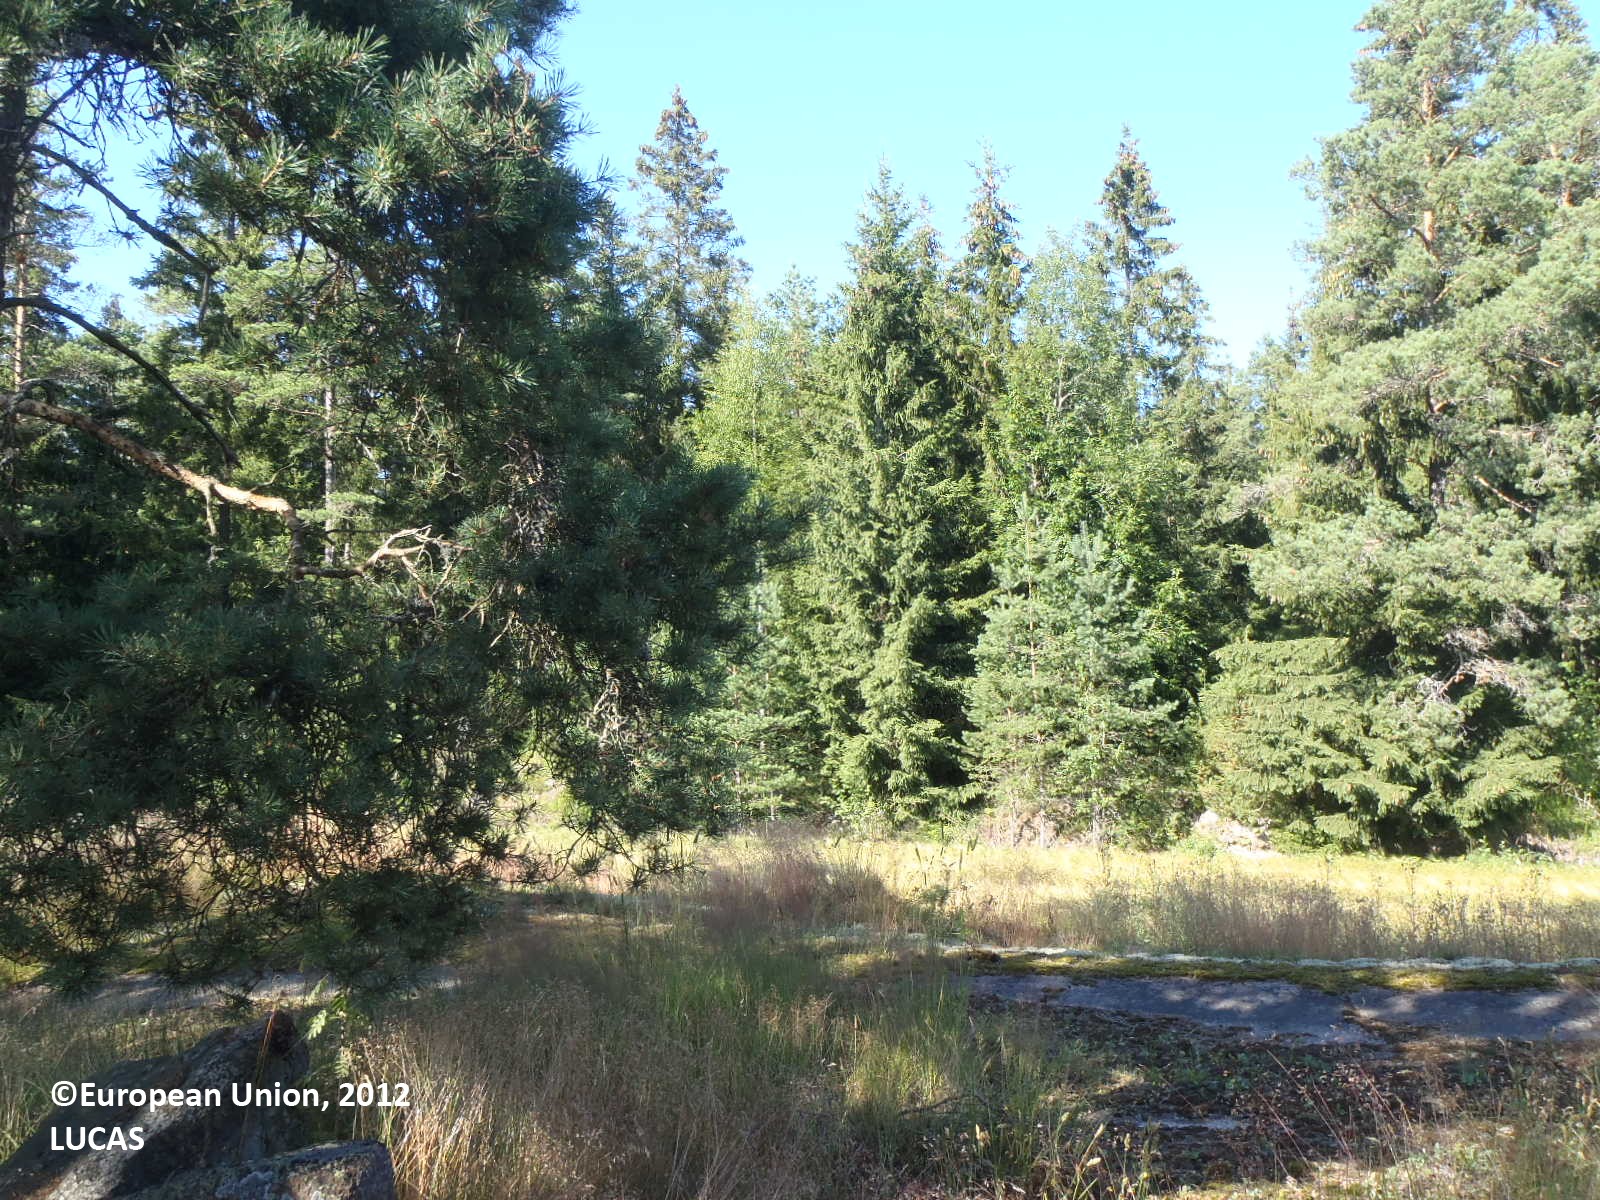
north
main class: Woodland
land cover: Pine dominated coniferous woodland
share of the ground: 25 - 50 %
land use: Forestry
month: July
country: FI
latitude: 60.6572
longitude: 21.7117
